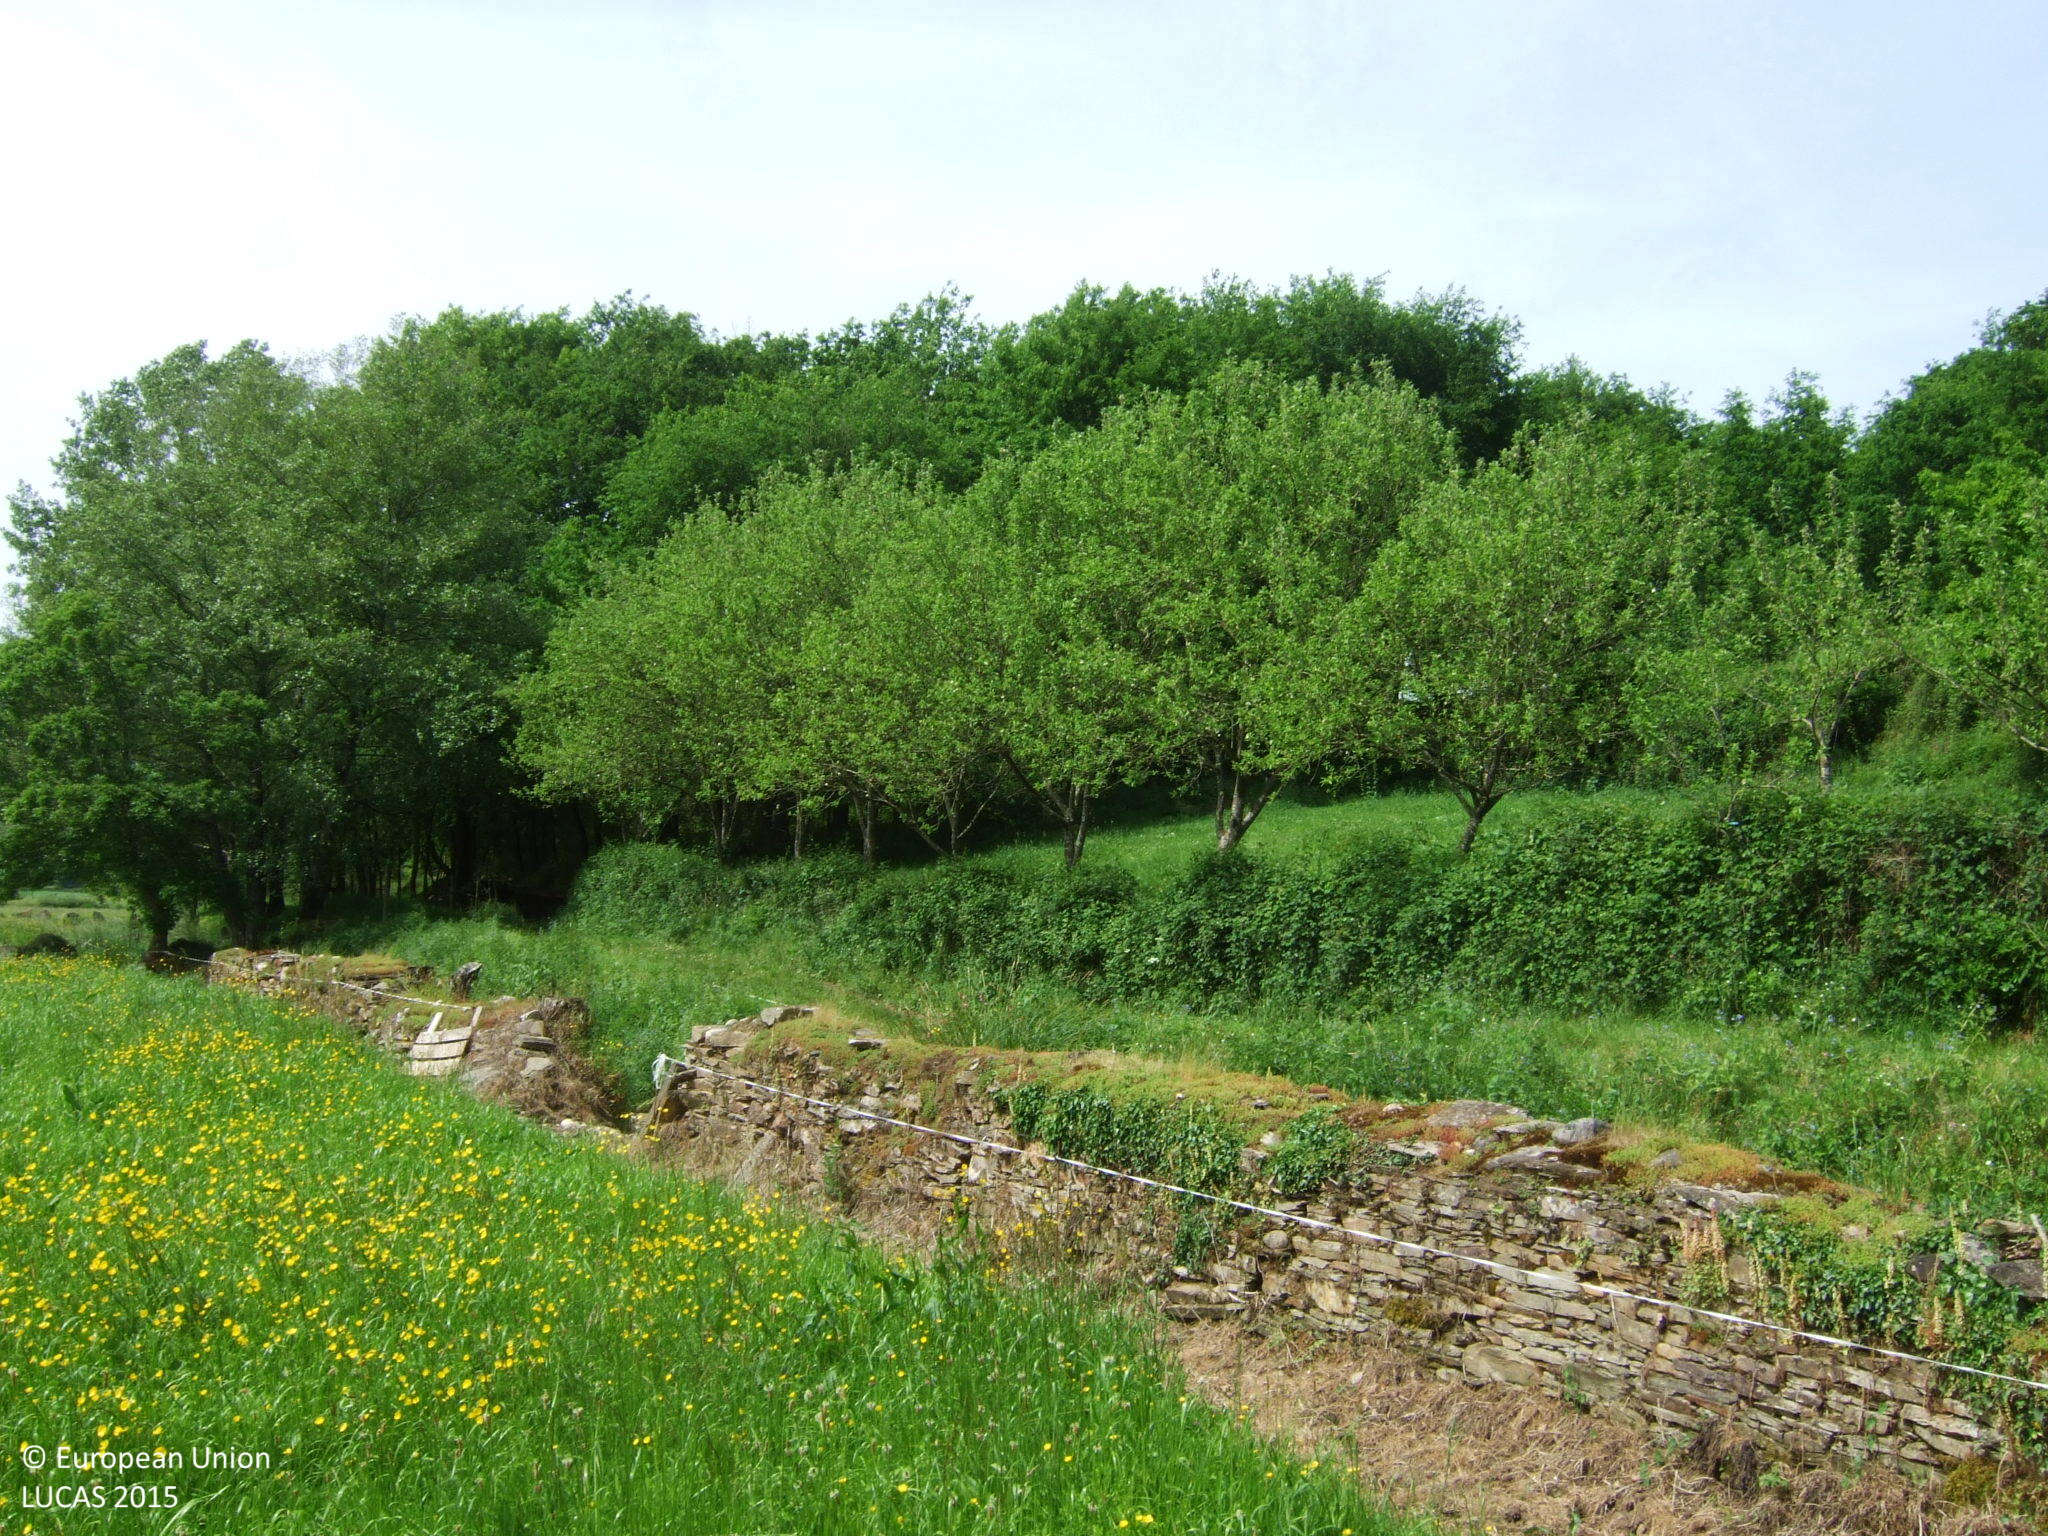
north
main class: Grassland
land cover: Grassland without tree/shrub cover
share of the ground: > 75 %
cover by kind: herbaceous plants 100 %
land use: Agriculture (excluding fallow land and kitchen gardens)
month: May
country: ES
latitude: 42.8589
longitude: -7.3382
